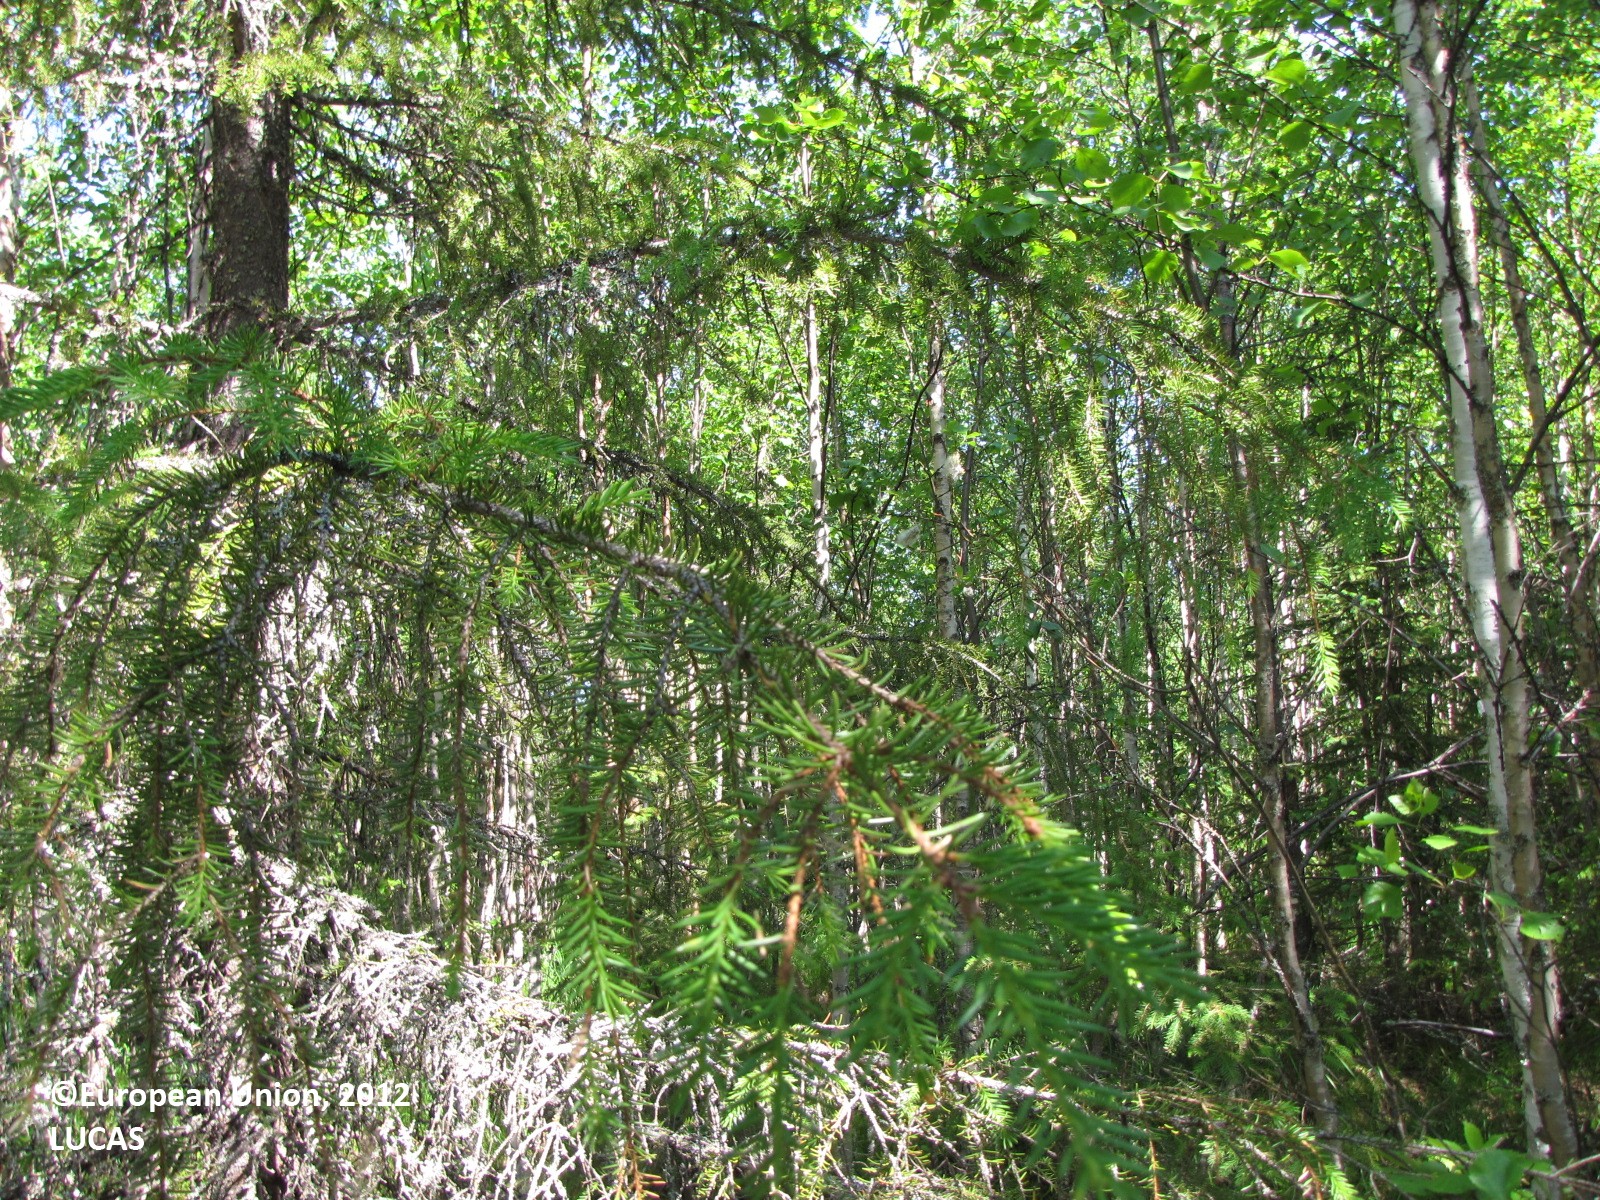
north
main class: Woodland
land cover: Other mixed woodland
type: boreal forest
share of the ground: > 75 %
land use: Forestry
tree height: > 5 m
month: July
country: FI
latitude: 66.2922
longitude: 25.3309
